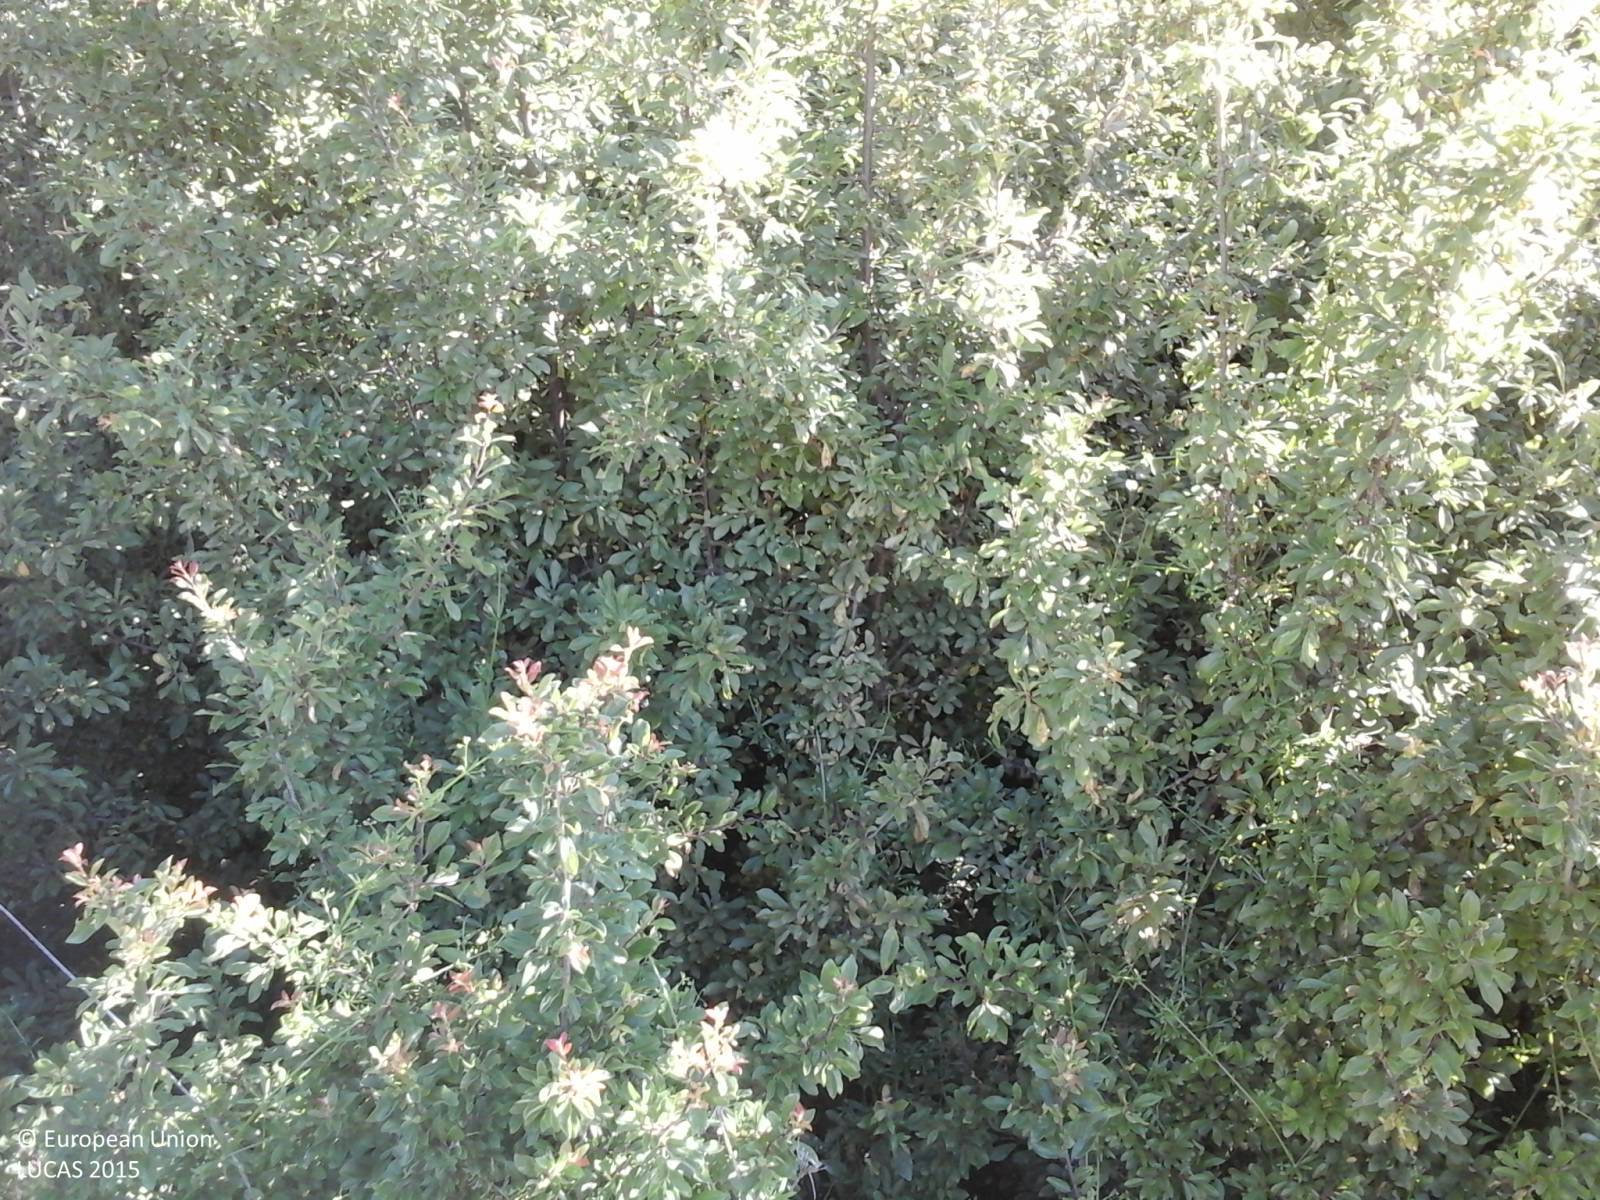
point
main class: Shrubland
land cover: Shrubland without tree cover
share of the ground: > 75 %
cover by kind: shrubs 100 %
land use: Semi-natural and natural areas not in use
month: July
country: IT
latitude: 42.4899
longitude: 13.3596
